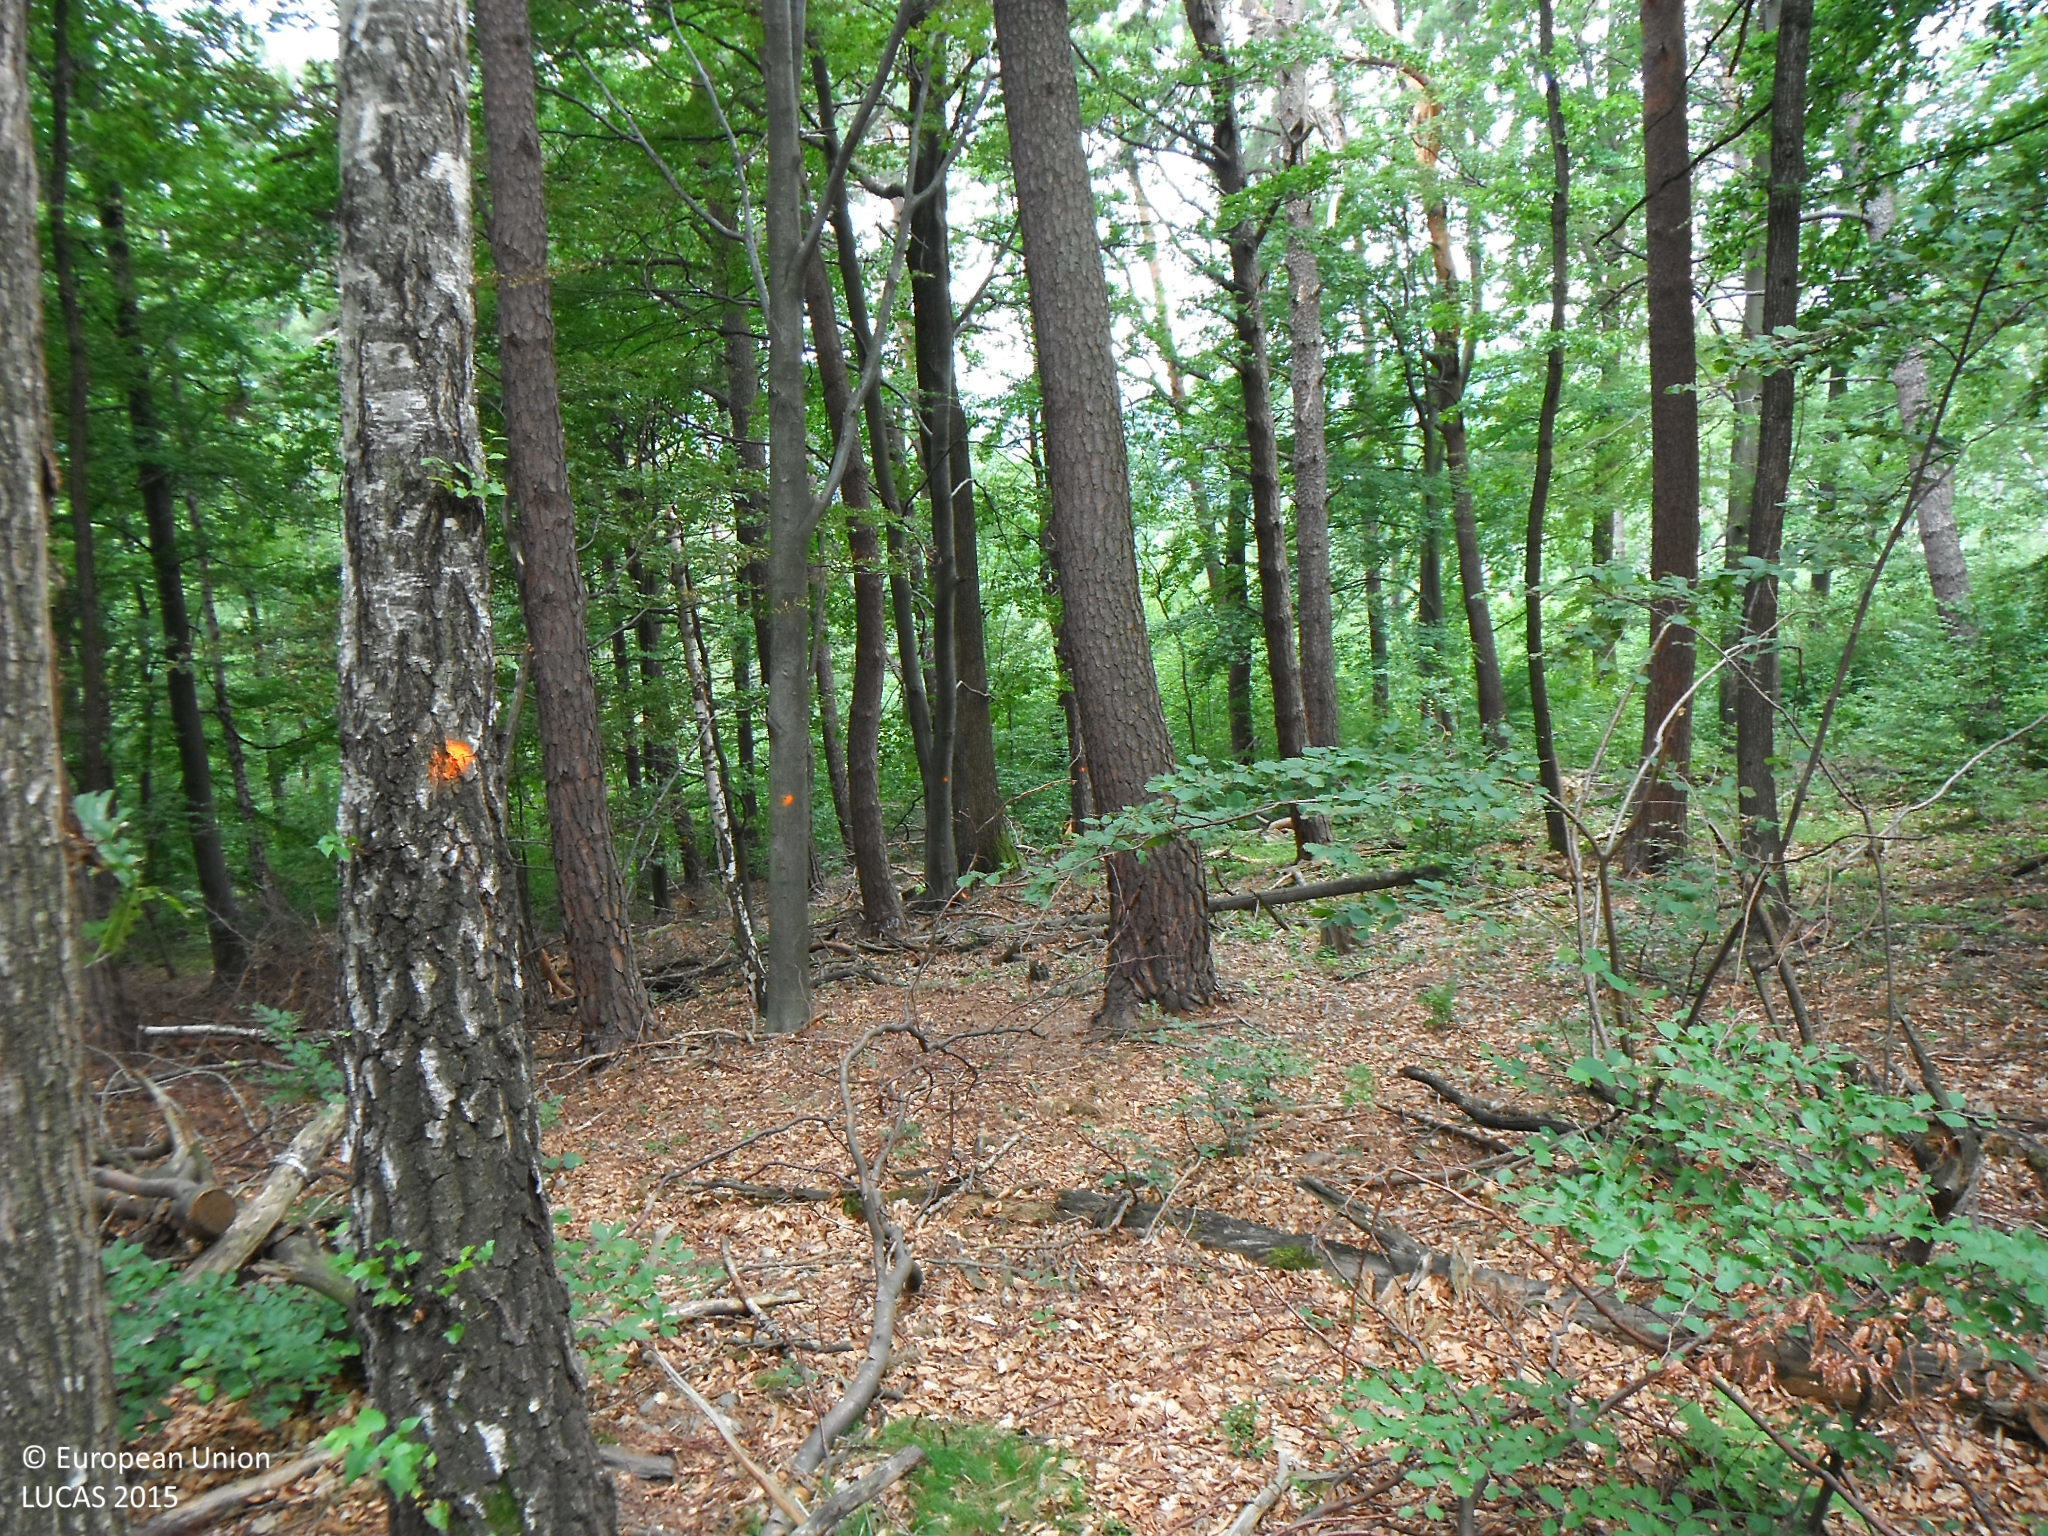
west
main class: Woodland
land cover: Pine dominated mixed woodland
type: hemiboreal forest and nemoral coniferous forest and mixed broadleaved-coniferous forest
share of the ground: 50 - 75 %
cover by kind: coniferous forest trees 65 %, broadleaved forest trees 35 %
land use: Forestry
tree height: > 5 m
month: July
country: SK
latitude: 48.7383
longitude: 21.0423
